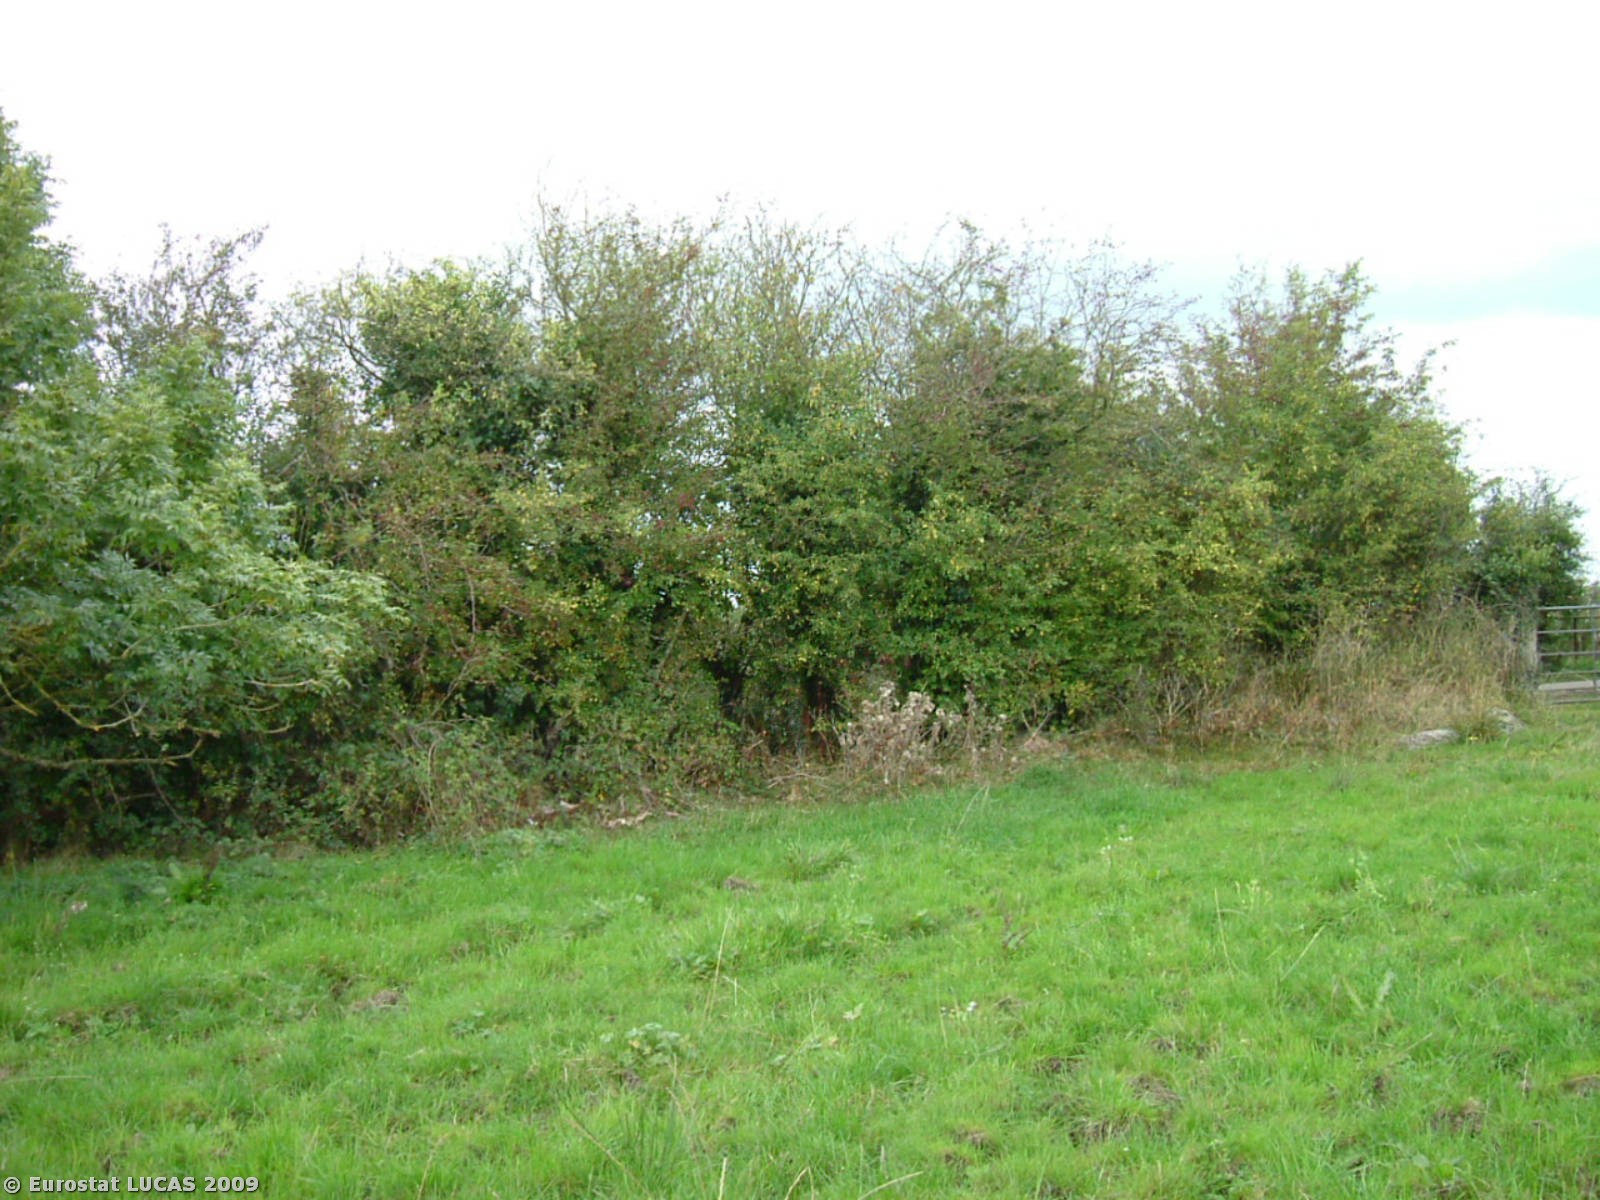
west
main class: Grassland
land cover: Grassland without tree/shrub cover
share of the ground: > 75 %
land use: Agriculture (excluding fallow land and kitchen gardens)
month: October
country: IE
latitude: 52.5380
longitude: -8.2149
